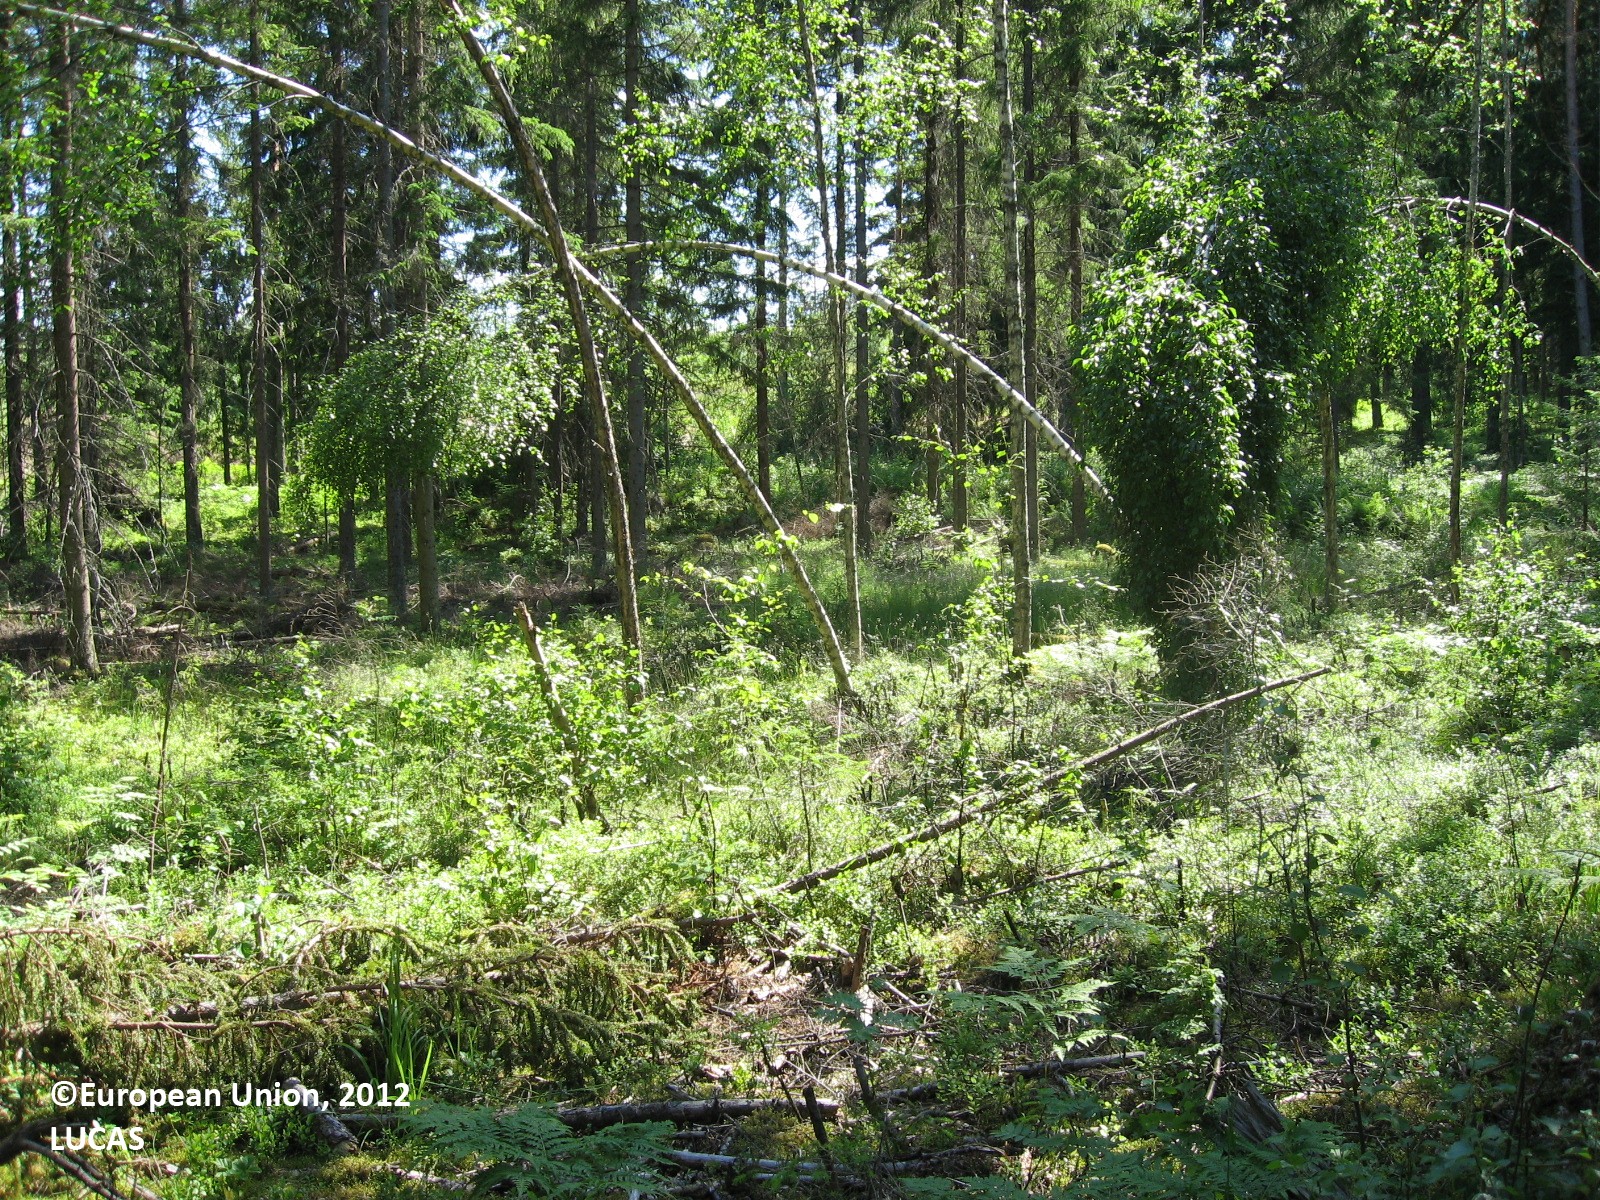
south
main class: Woodland
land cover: Spruce dominated coniferous woodland
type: boreal forest
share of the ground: 50 - 75 %
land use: Forestry
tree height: > 5 m
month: July
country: FI
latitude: 61.0878
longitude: 26.4481
